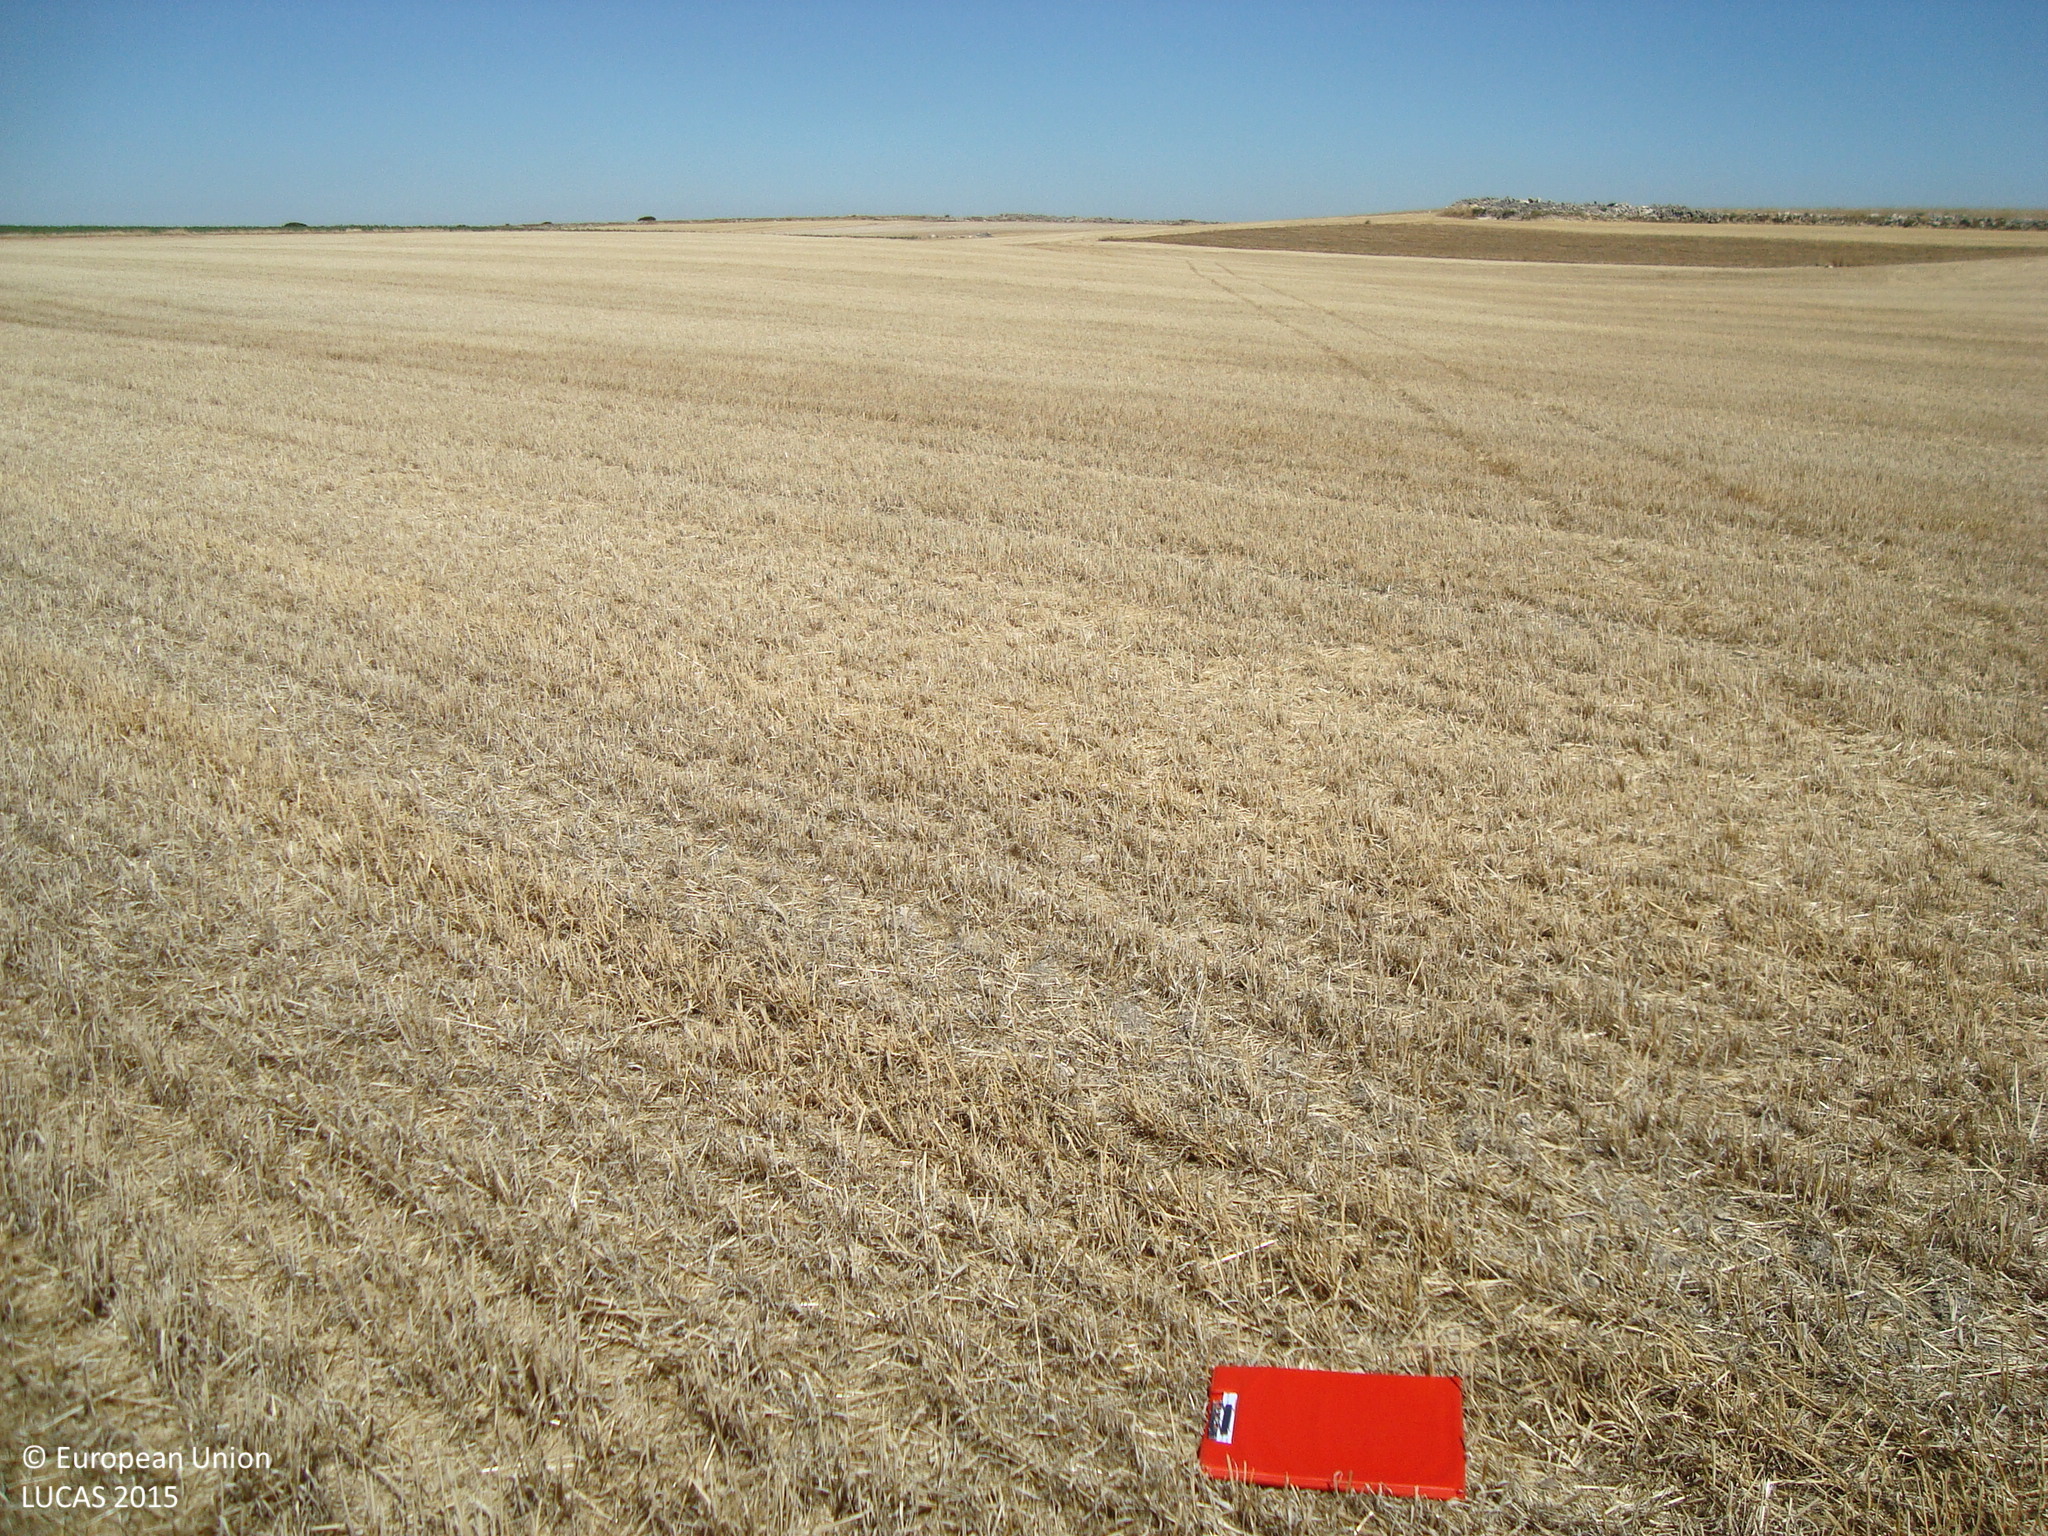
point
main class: Cropland
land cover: Barley
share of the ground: > 75 %
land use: Agriculture (excluding fallow land and kitchen gardens)
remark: Harvested field
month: July
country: ES
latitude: 41.8619
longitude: -3.8510
